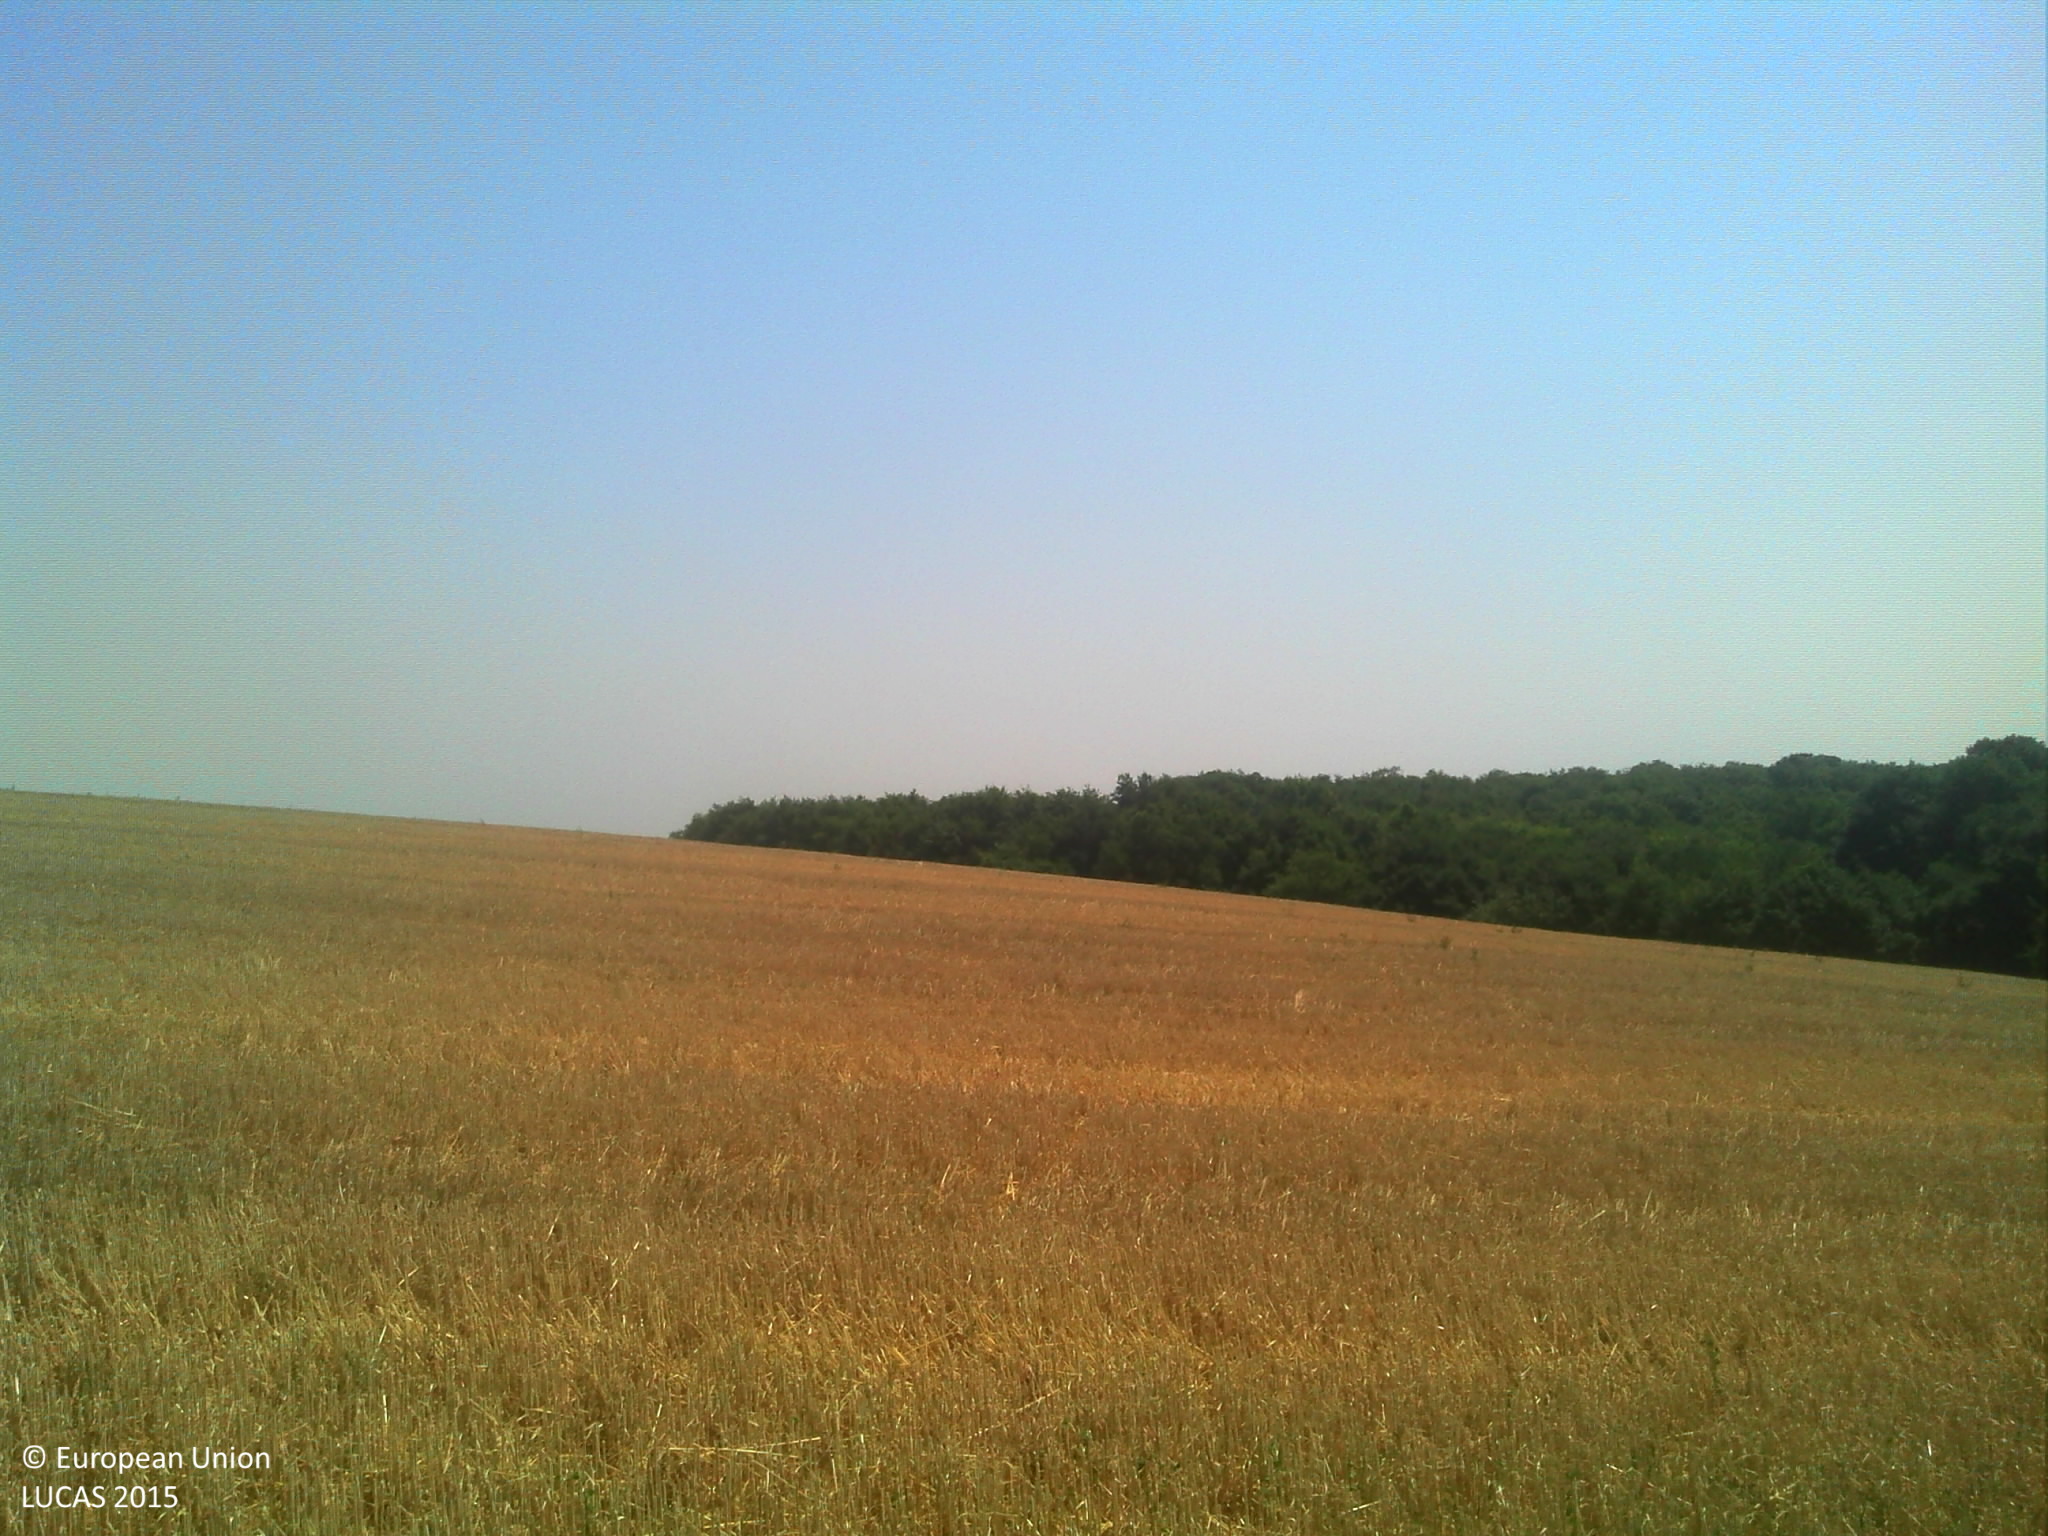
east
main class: Cropland
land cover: Common wheat
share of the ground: > 75 %
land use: Agriculture (excluding fallow land and kitchen gardens)
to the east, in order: Common wheat
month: July
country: FR
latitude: 43.3671
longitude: 1.0800
